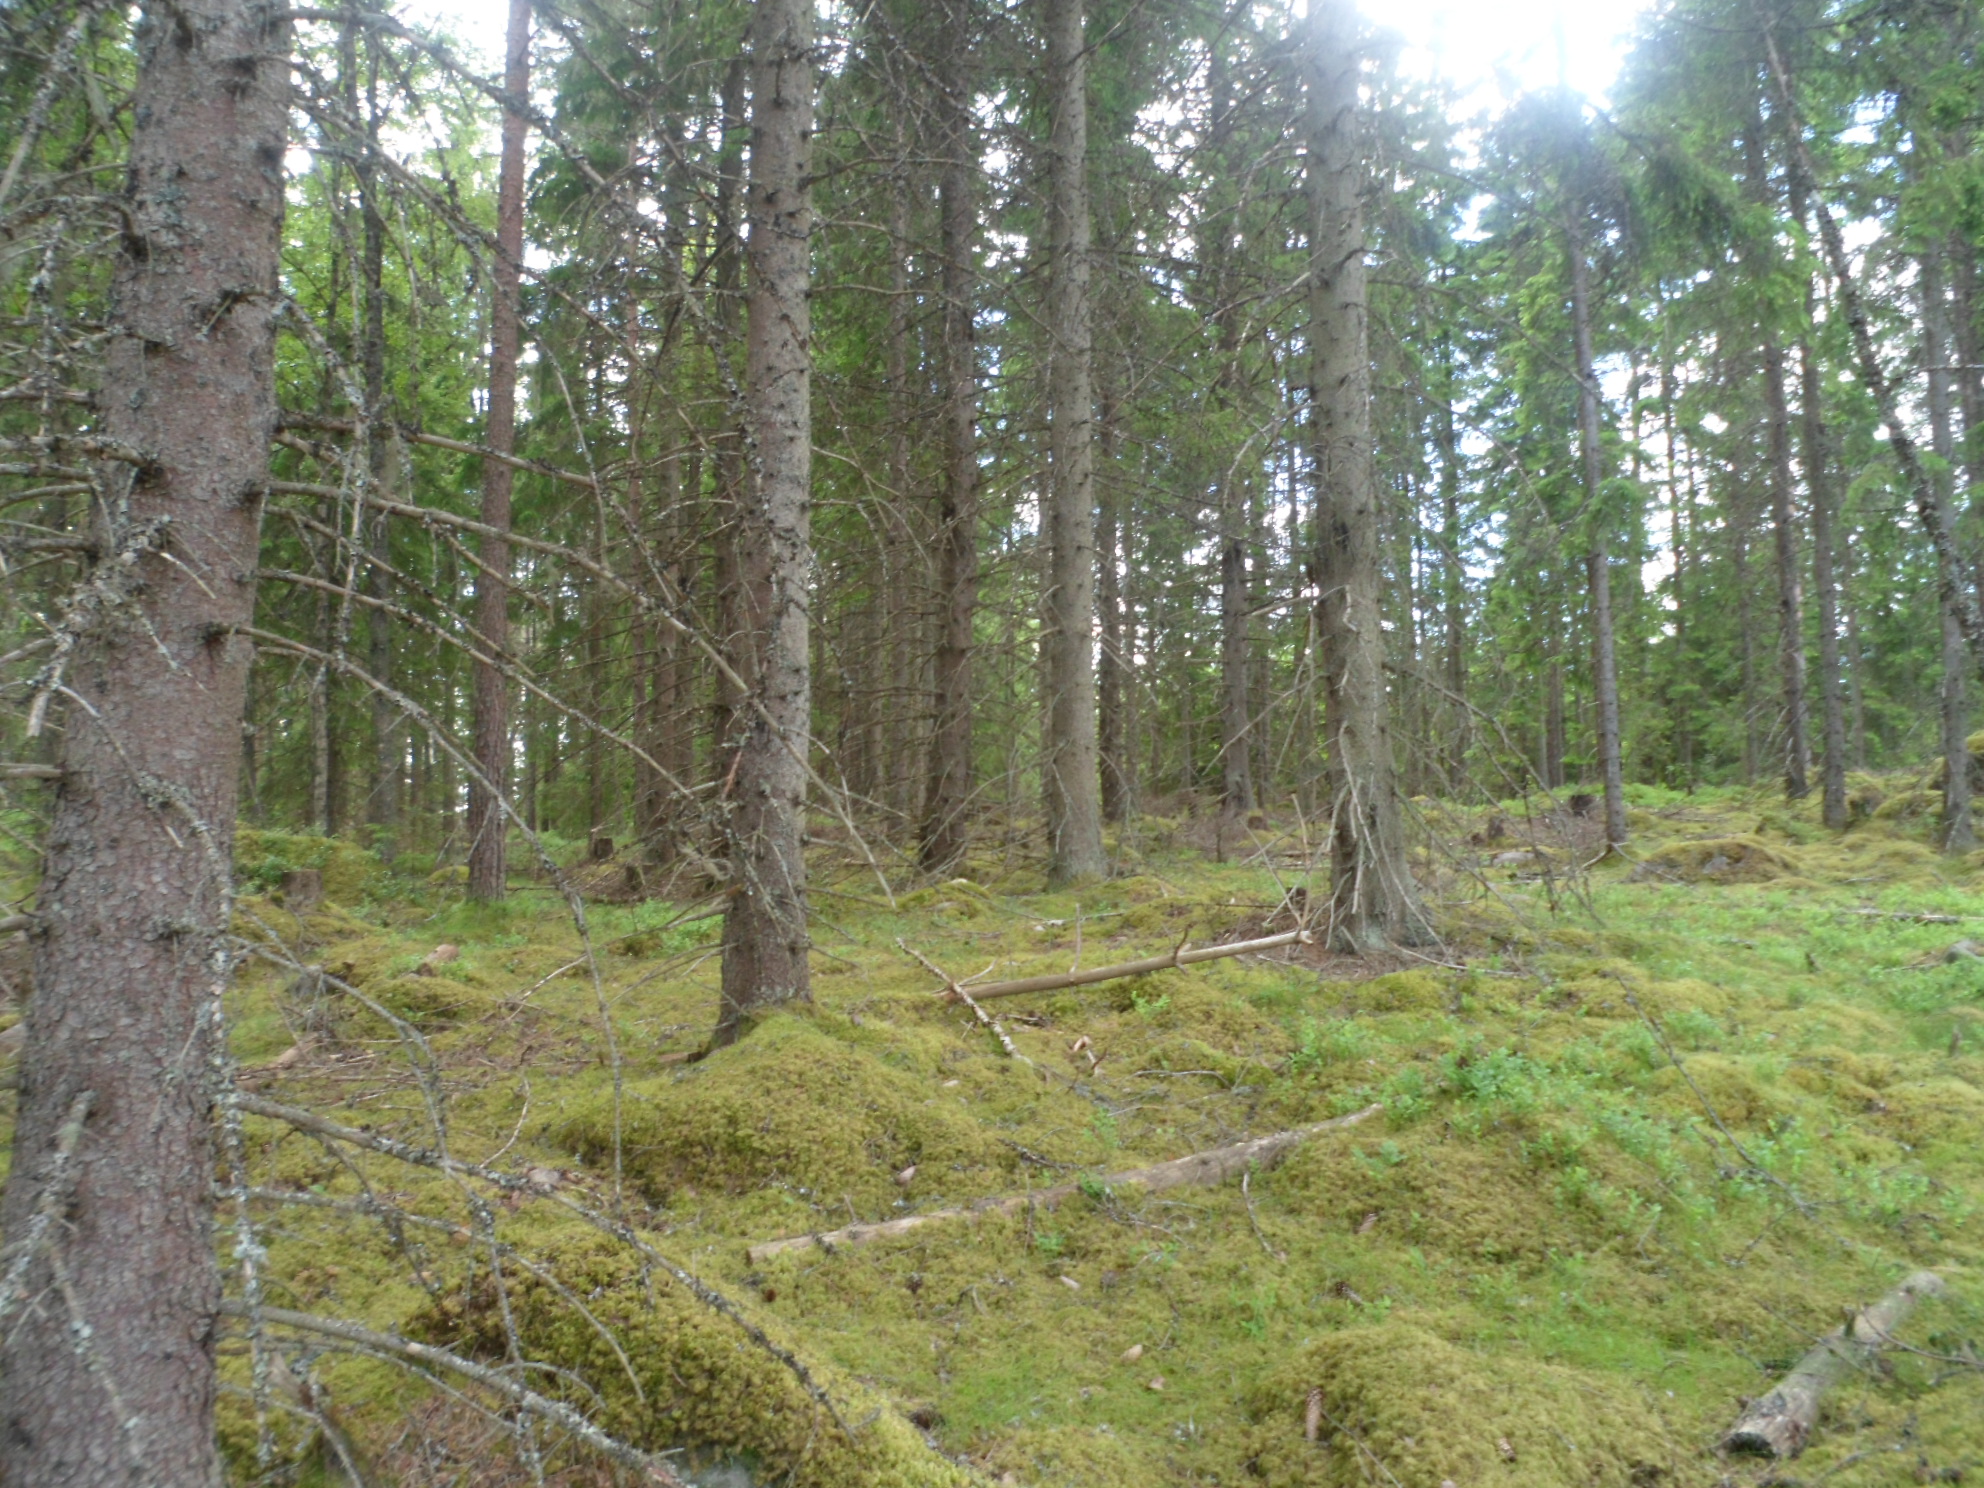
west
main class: Woodland
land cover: Spruce dominated coniferous woodland
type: boreal forest
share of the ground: 50 - 75 %
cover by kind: coniferous forest trees 60 %, shrubs 15 %, lichens and mosses 15 %, broadleaved forest trees 5 %, herbaceous plants 5 %
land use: Forestry
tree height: > 5 m
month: July
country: SE
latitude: 57.5354
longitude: 14.3885
